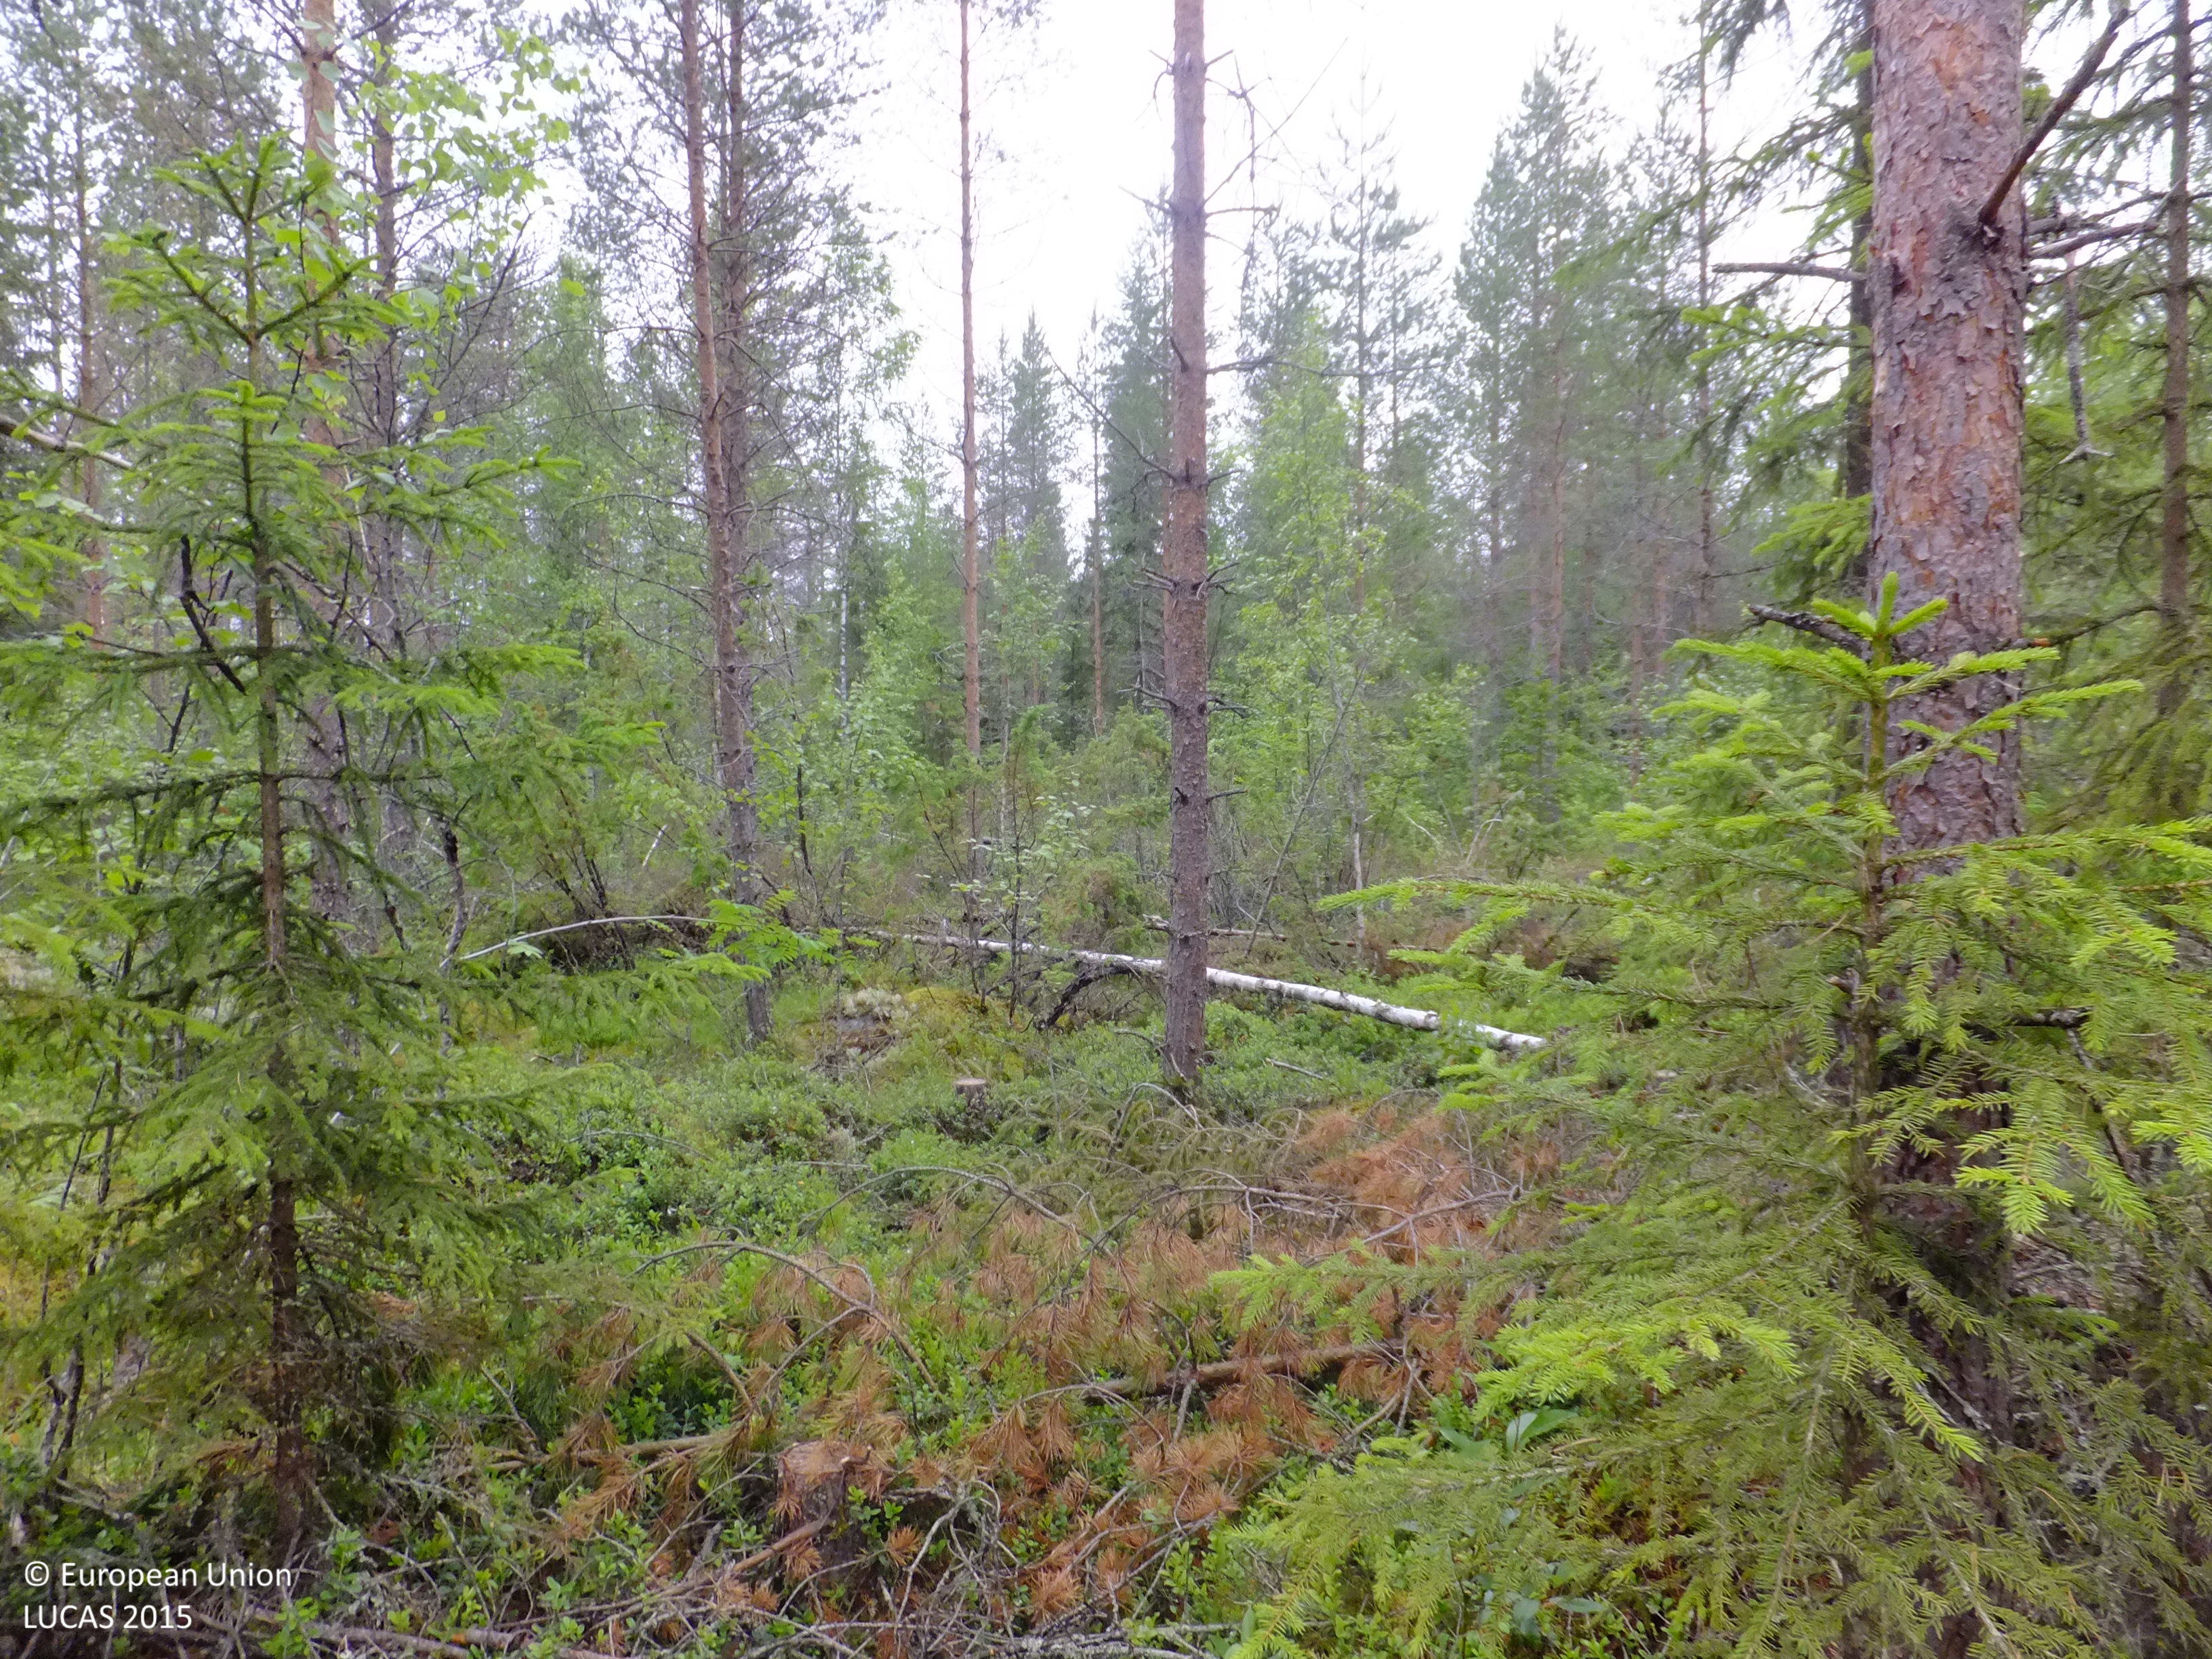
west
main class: Woodland
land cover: Other coniferous woodland
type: boreal forest
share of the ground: > 75 %
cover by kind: coniferous forest trees 70 %, broadleaved forest trees 10 %, shrubs 10 %, herbaceous plants 5 %, lichens and mosses 5 %
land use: Forestry
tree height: > 5 m
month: July
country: FI
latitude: 63.1689
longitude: 24.5613
